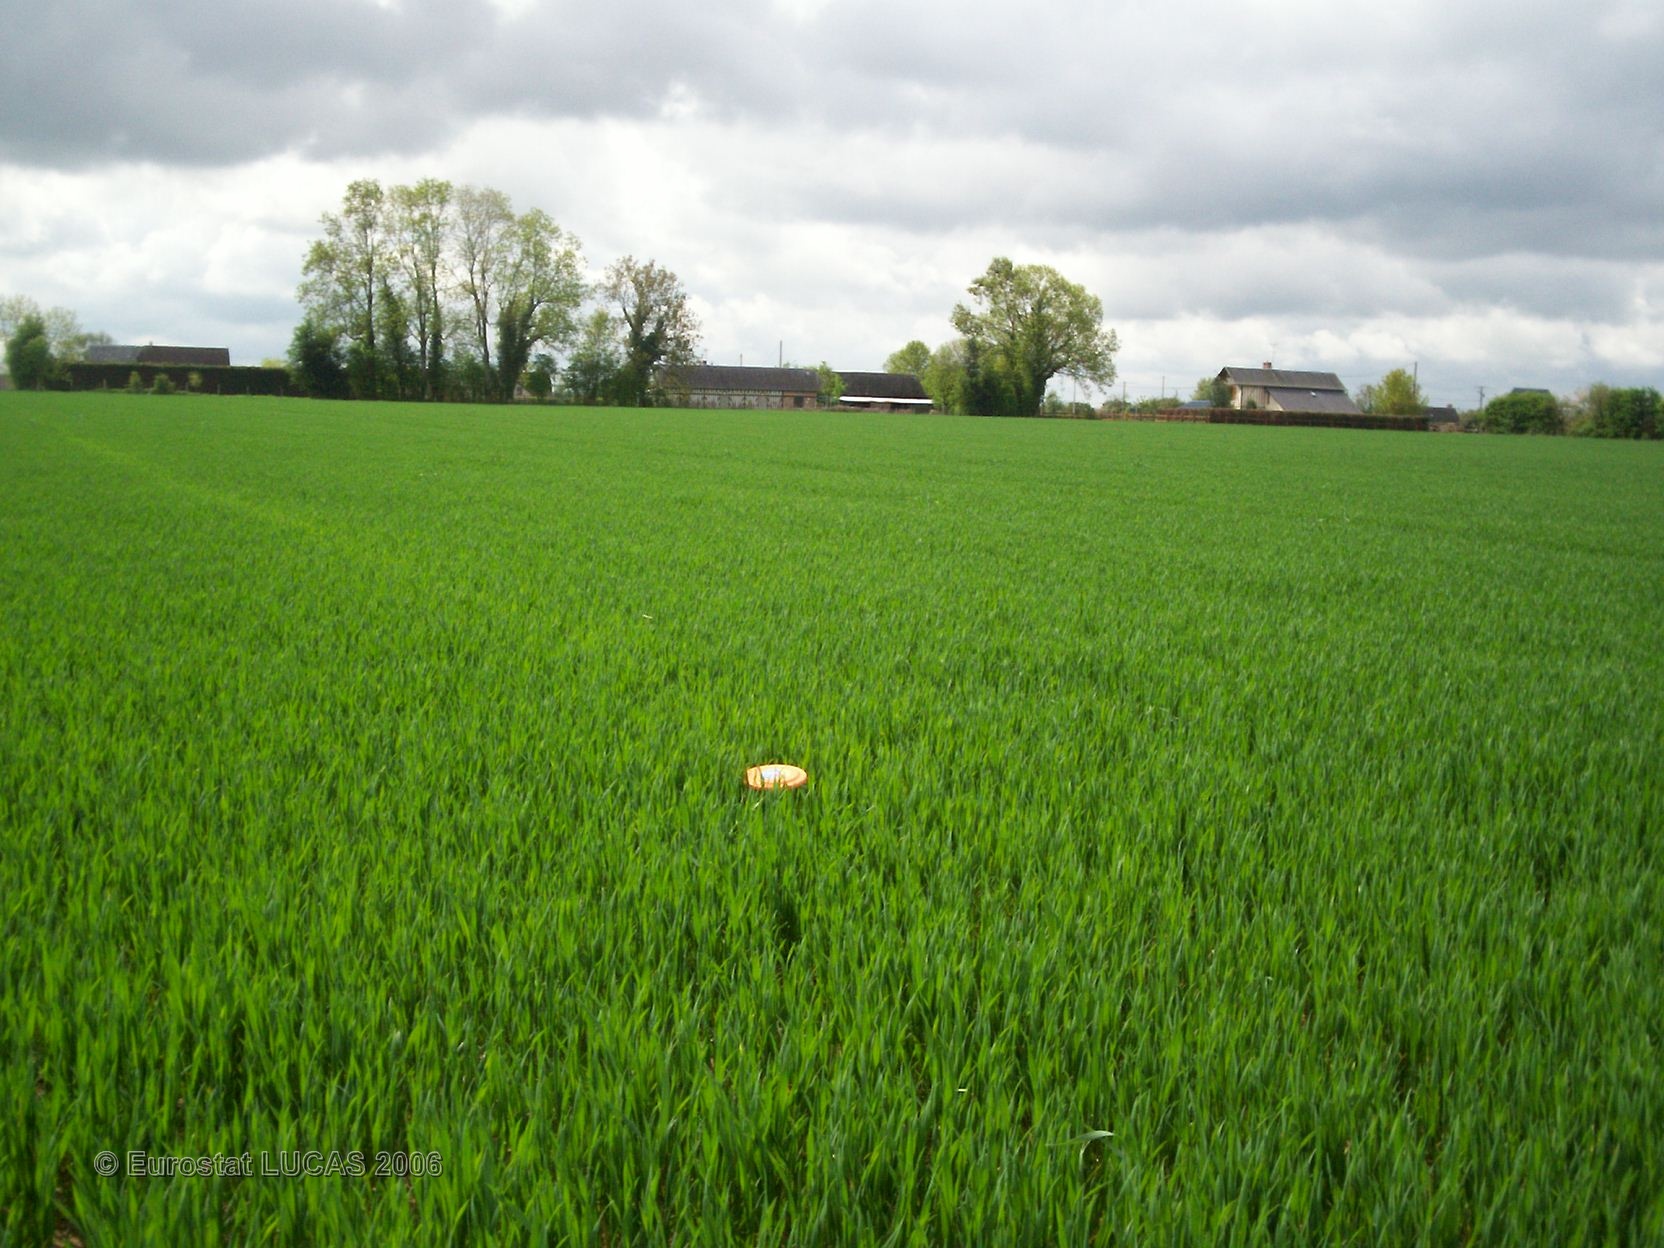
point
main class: Cropland
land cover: Common wheat
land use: Agriculture (excluding fallow land and kitchen gardens)
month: May
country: FR
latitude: 49.0638
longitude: 0.5168
